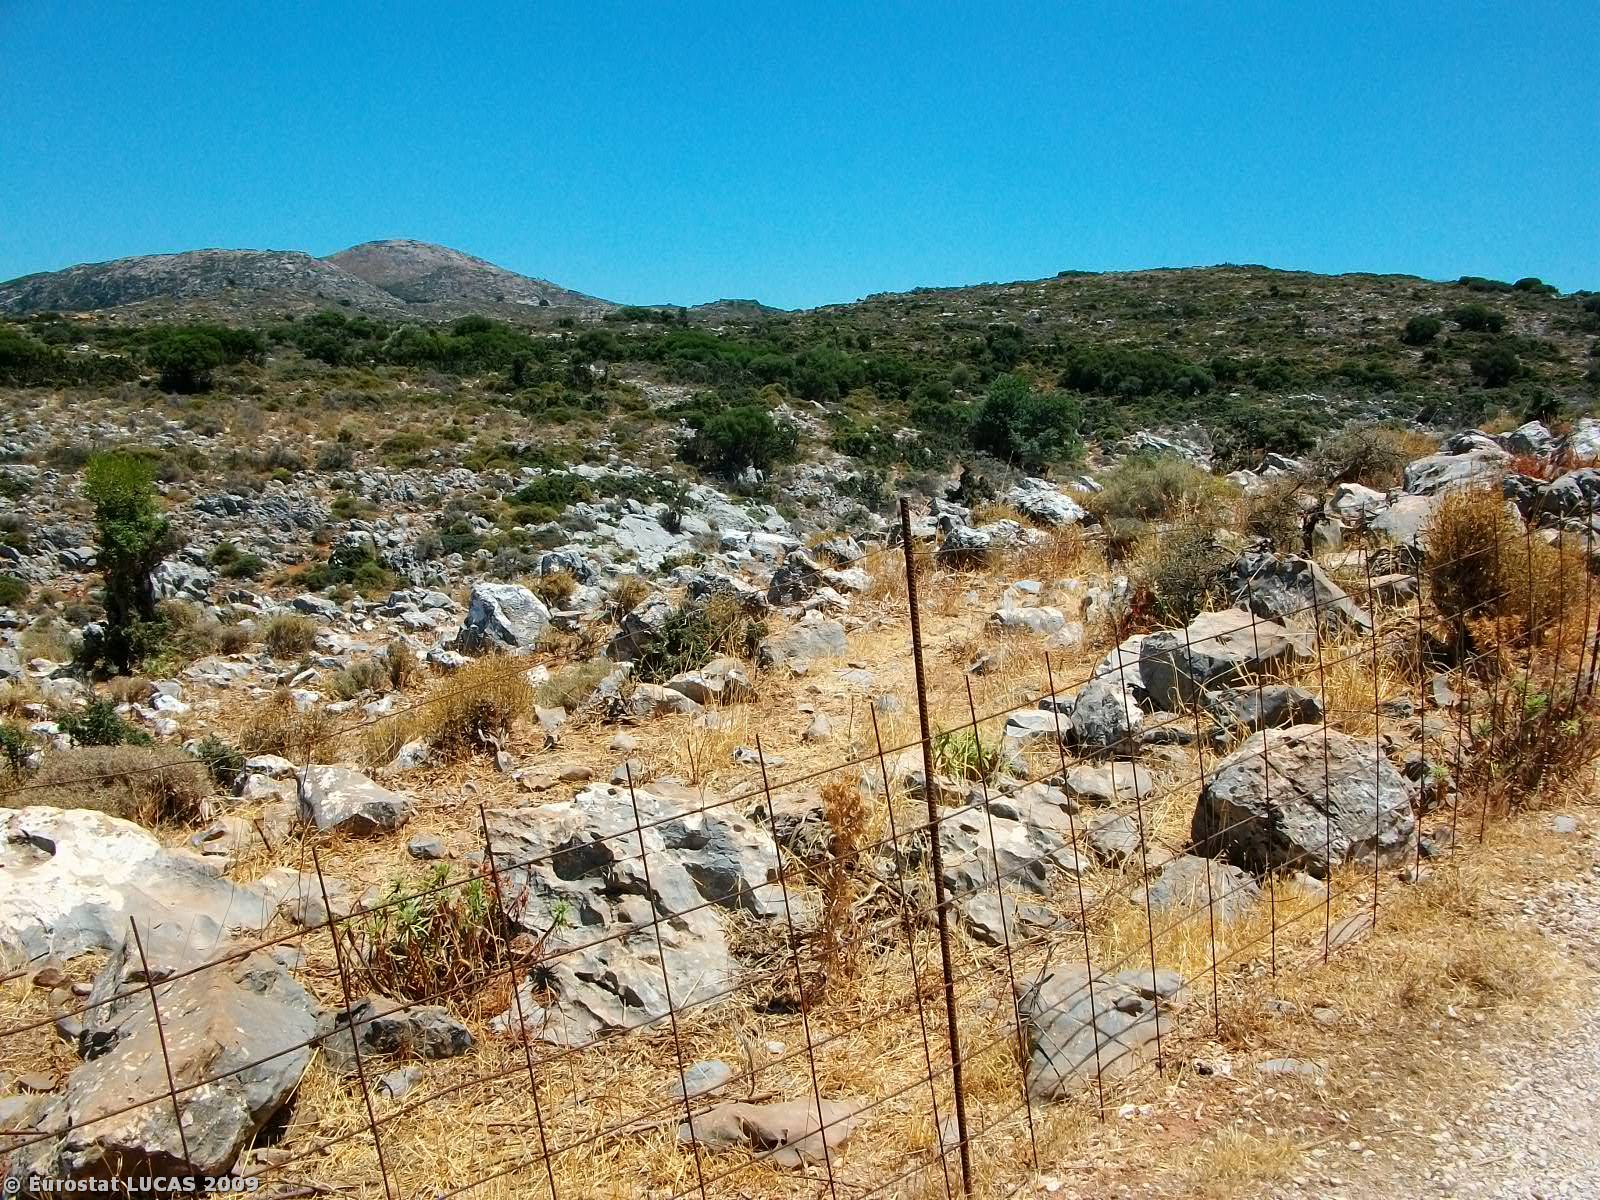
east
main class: Shrubland
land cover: Shrubland without tree cover
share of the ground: 50 - 75 %
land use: Unused
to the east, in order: Shrubland without tree cover; Rock outcrops; Shrubland without tree cover; Tracks; Shrubland without tree cover; Tracks; Shrubland without tree cover; Tracks; Shrubland without tree cover
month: July
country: GR
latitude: 35.3257
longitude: 24.9408
